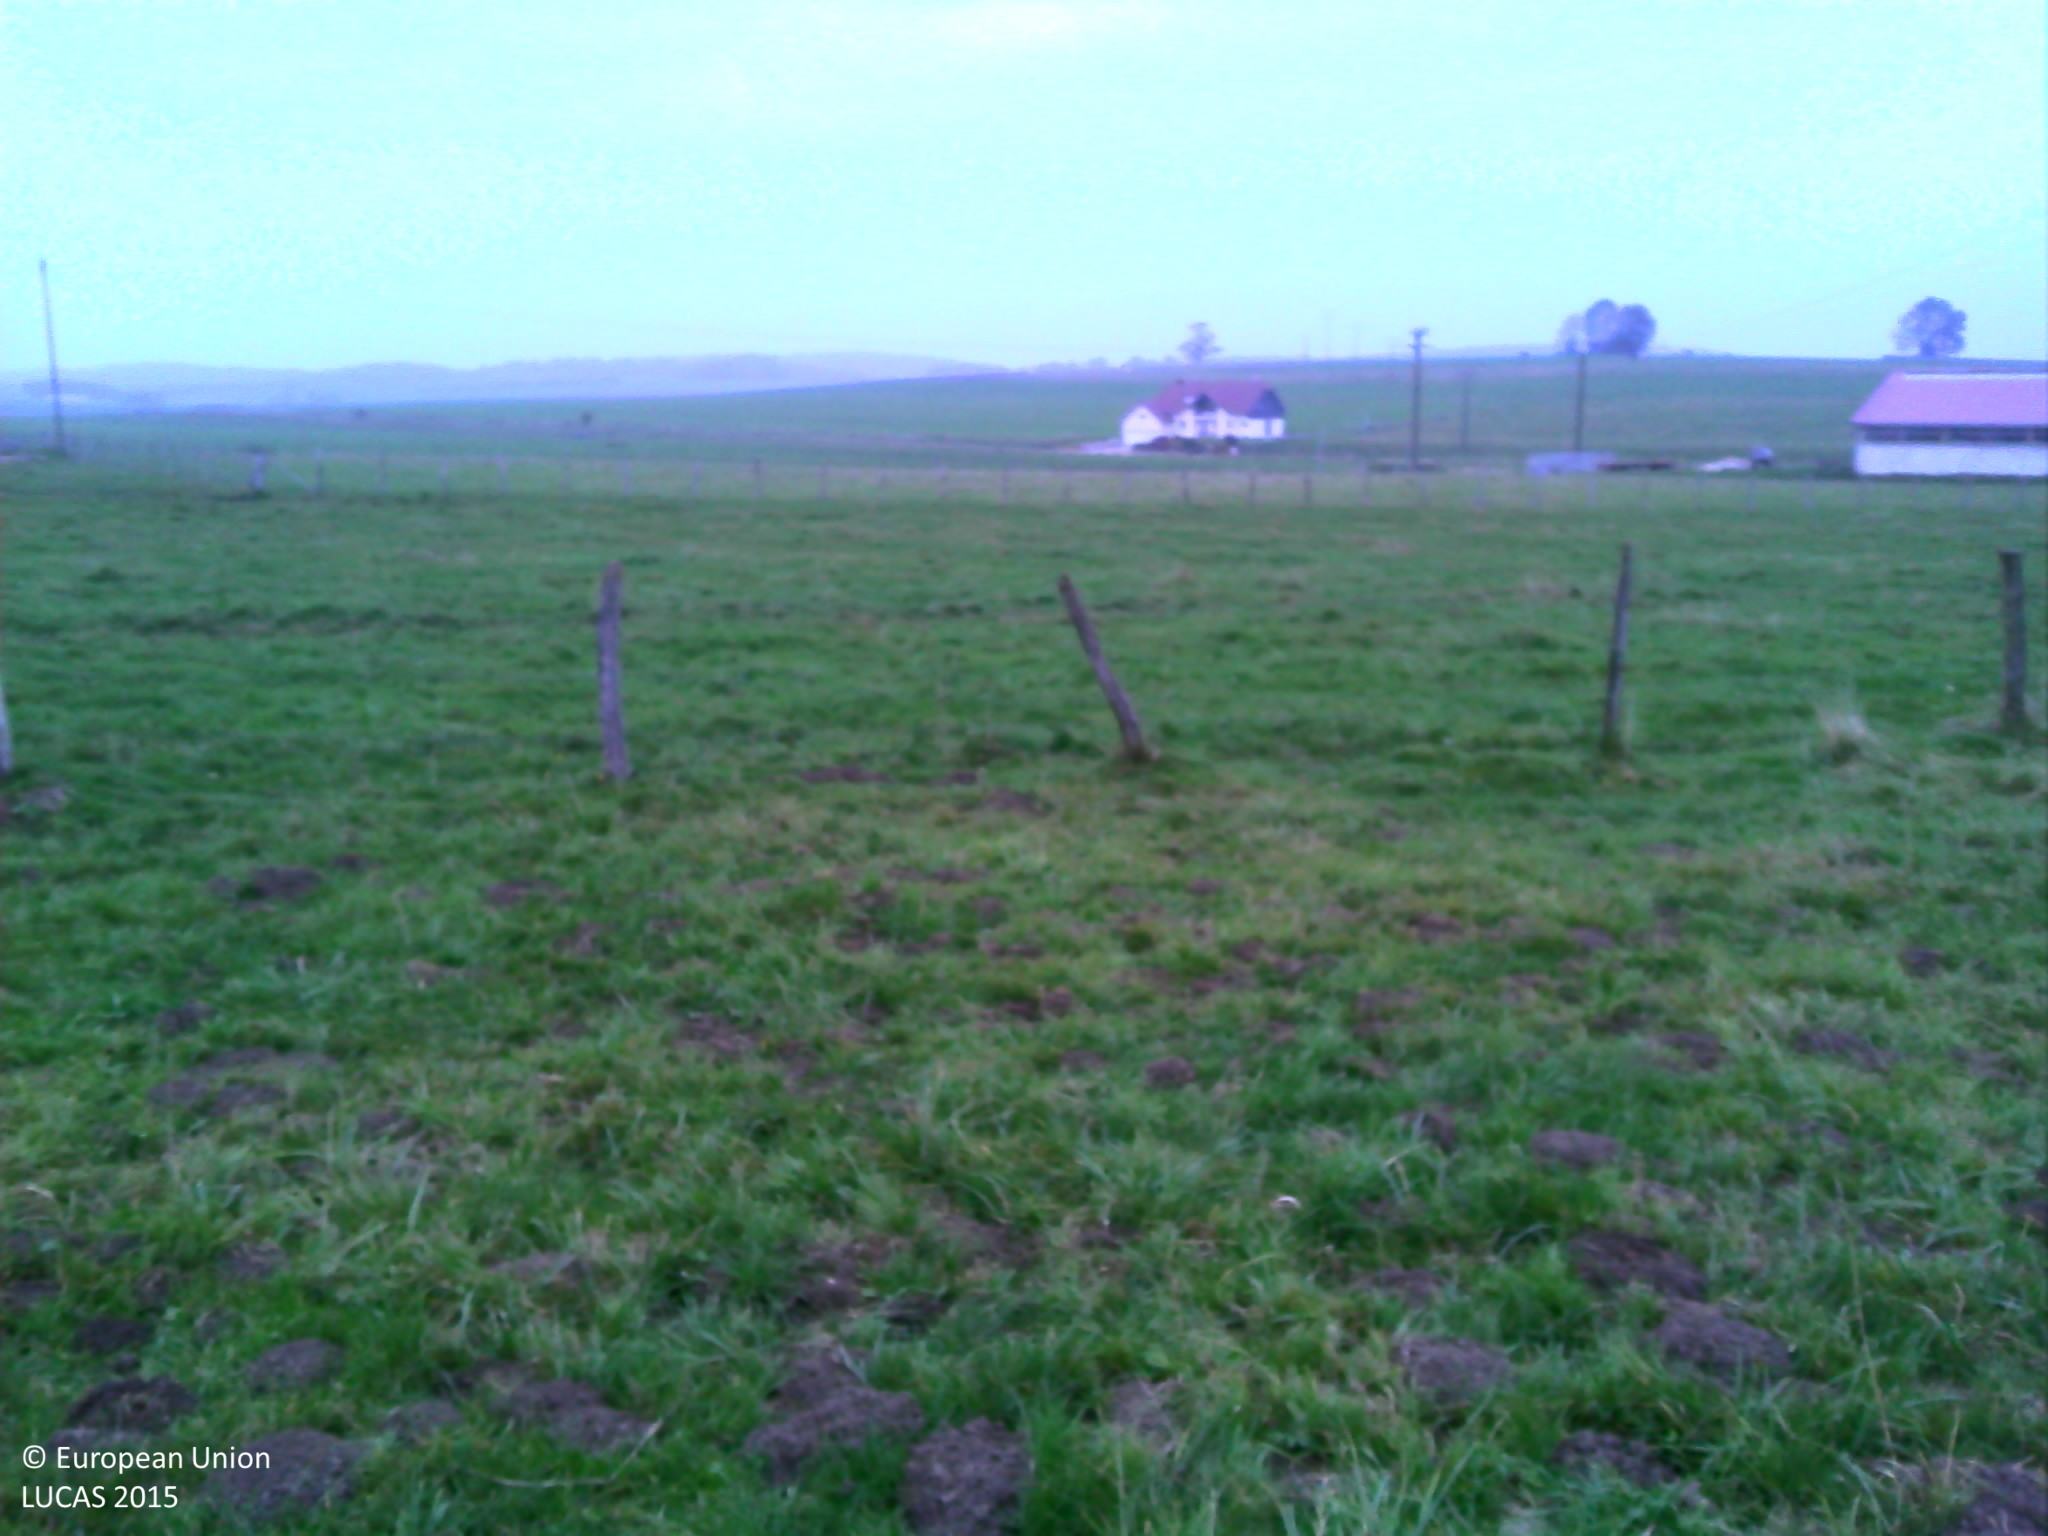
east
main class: Grassland
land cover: Grassland without tree/shrub cover
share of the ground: > 75 %
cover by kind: herbaceous plants 100 %
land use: Agriculture (excluding fallow land and kitchen gardens)
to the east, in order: Grassland without tree/shrub cover; Fences; Grassland without tree/shrub cover; Fences; Grassland without tree/shrub cover; Electric lines; Grassland without tree/shrub cover; Fences; Grass margins; Paved roads, cycling and walking lanes; Grass margins; Fences; Grassland without tree/shrub cover
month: October
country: FR
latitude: 46.8923
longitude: 6.0780
